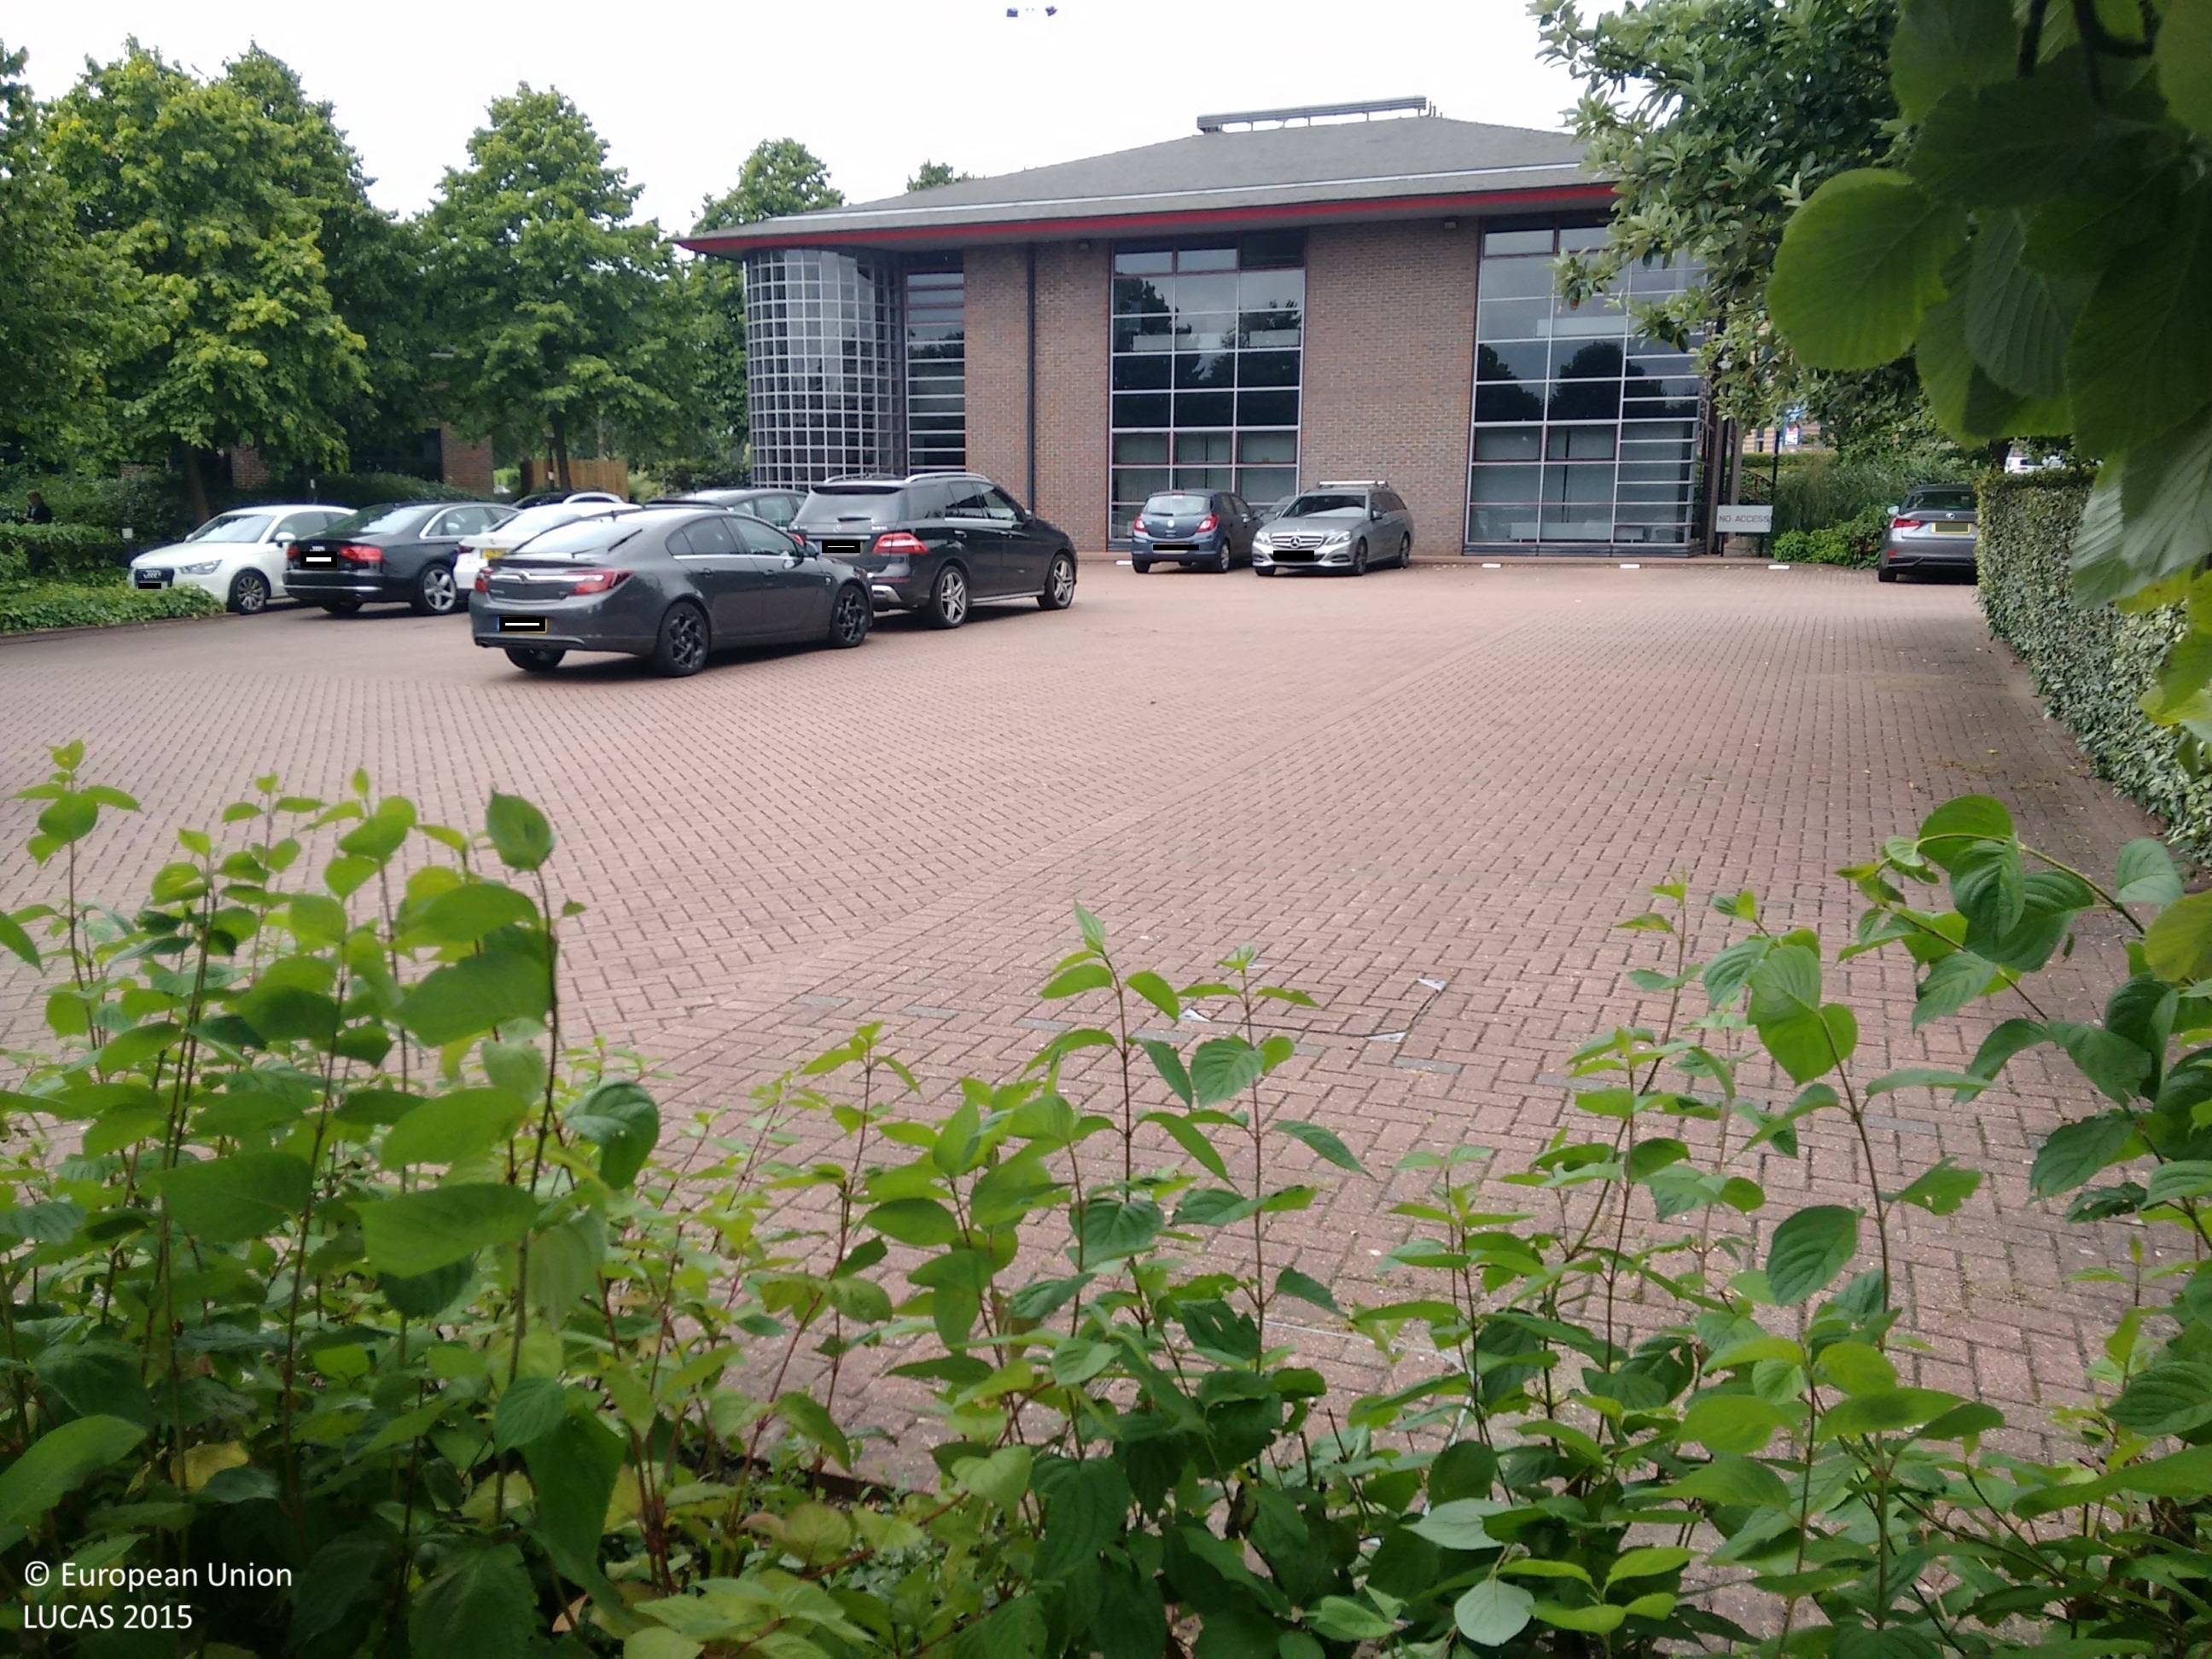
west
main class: Woodland
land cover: Broadleaved woodland
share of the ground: > 75 %
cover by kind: broadleaved forest trees 100 %
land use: Semi-natural and natural areas not in use
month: July
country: GB
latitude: 51.5423
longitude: -2.5688
